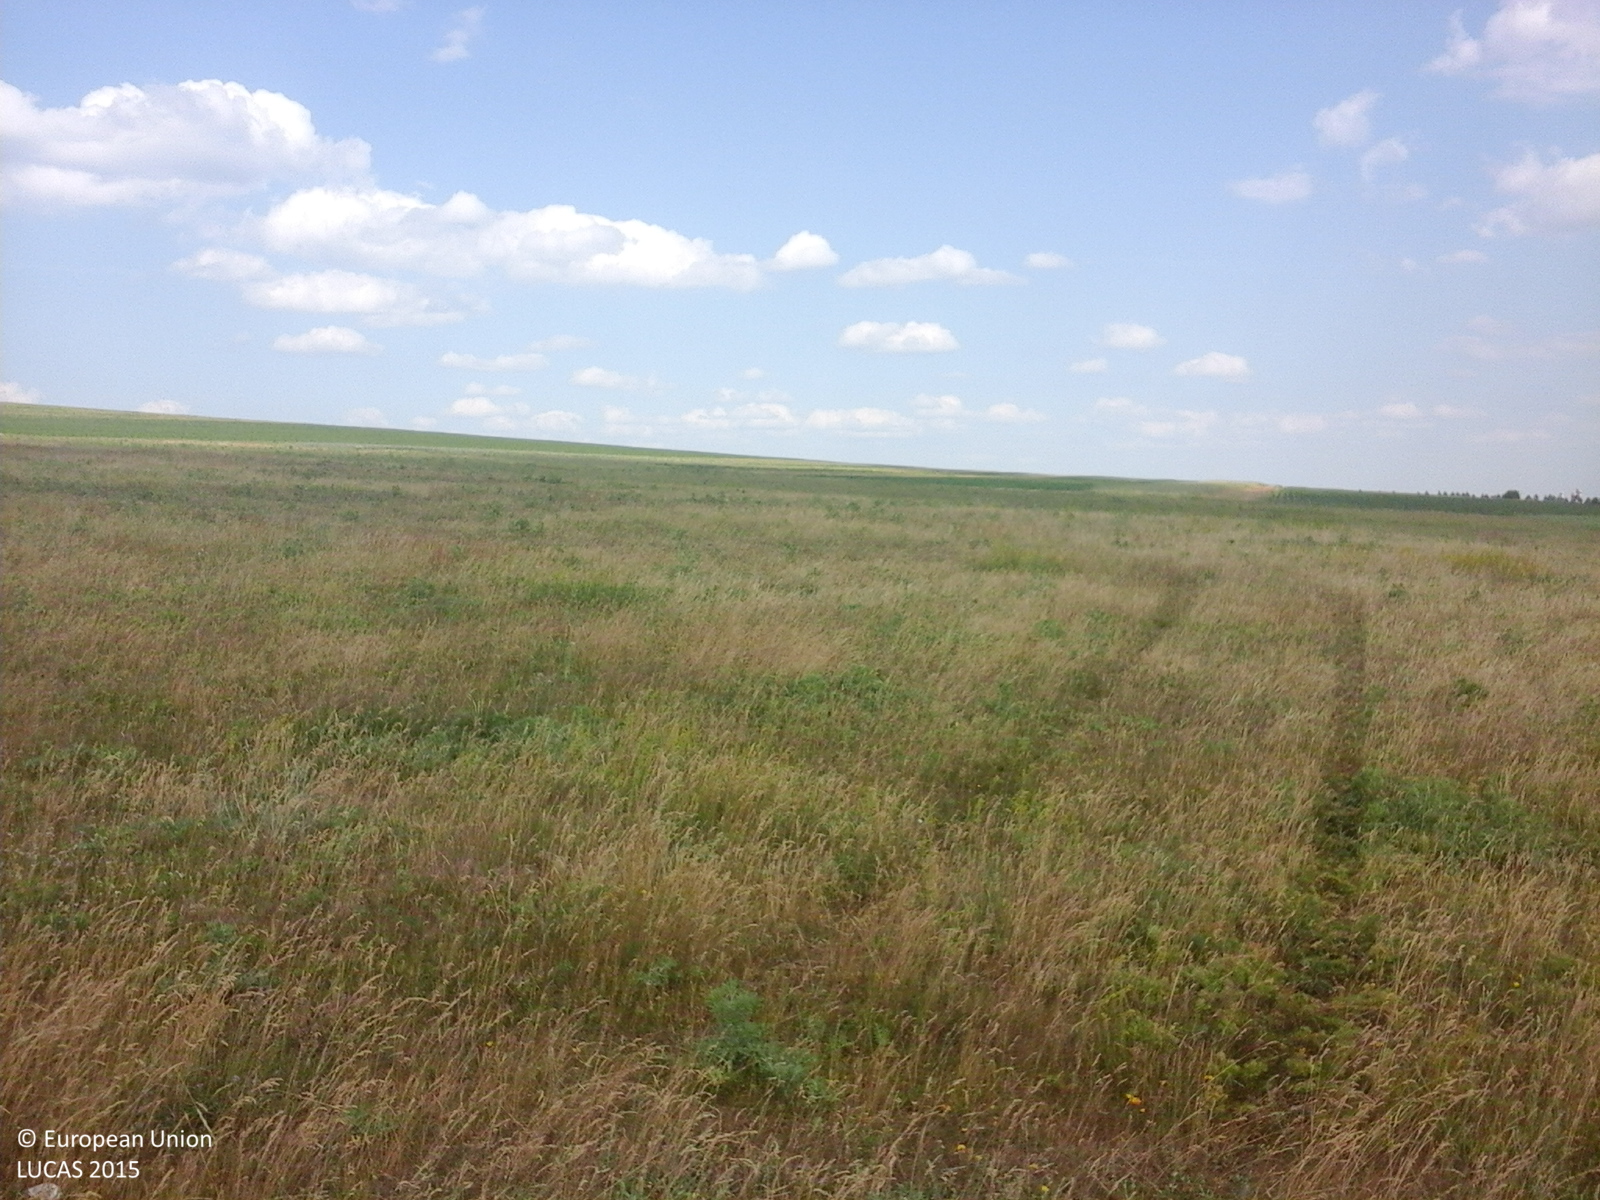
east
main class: Grassland
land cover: Grassland without tree/shrub cover
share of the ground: > 75 %
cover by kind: herbaceous plants 100 %
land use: Agriculture (excluding fallow land and kitchen gardens)
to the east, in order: Grassland without tree/shrub cover; Tracks; Grass margins; Maize; Grassland without tree/shrub cover
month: June
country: RO
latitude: 47.6754
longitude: 26.3216
